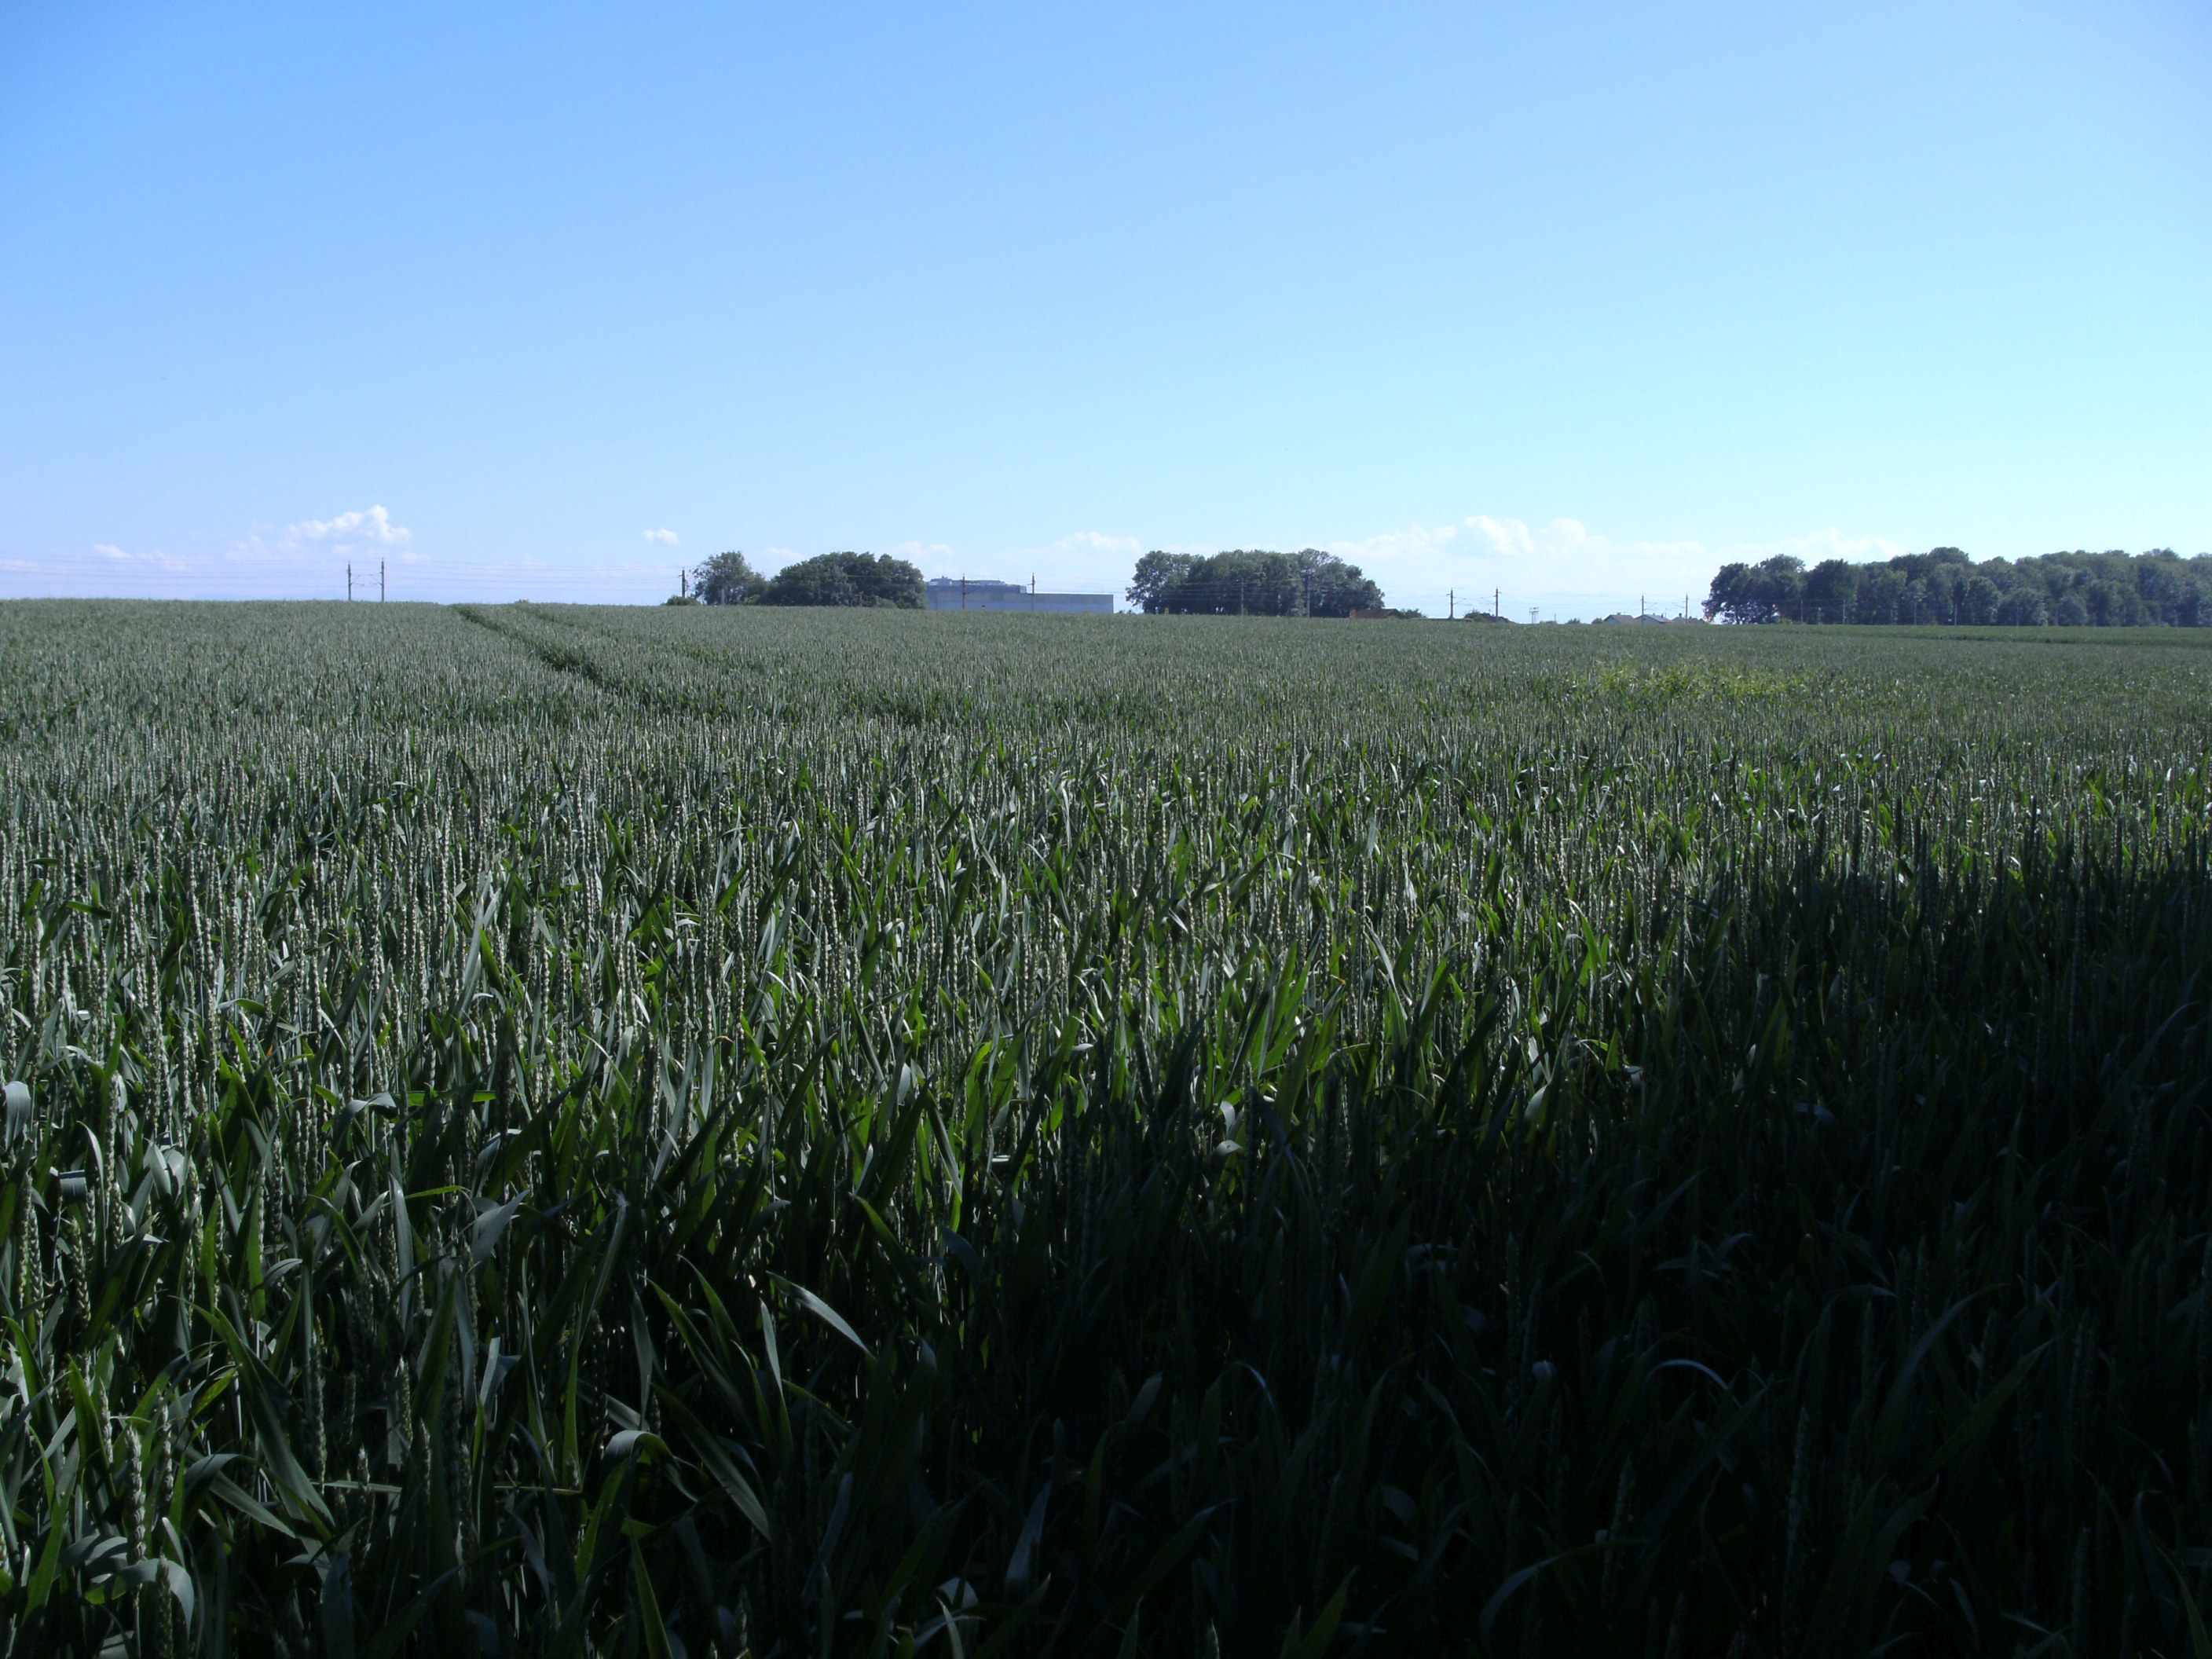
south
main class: Cropland
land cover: Common wheat
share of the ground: > 75 %
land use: Agriculture (excluding fallow land and kitchen gardens)
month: June
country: AT
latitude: 48.2352
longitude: 14.1602
